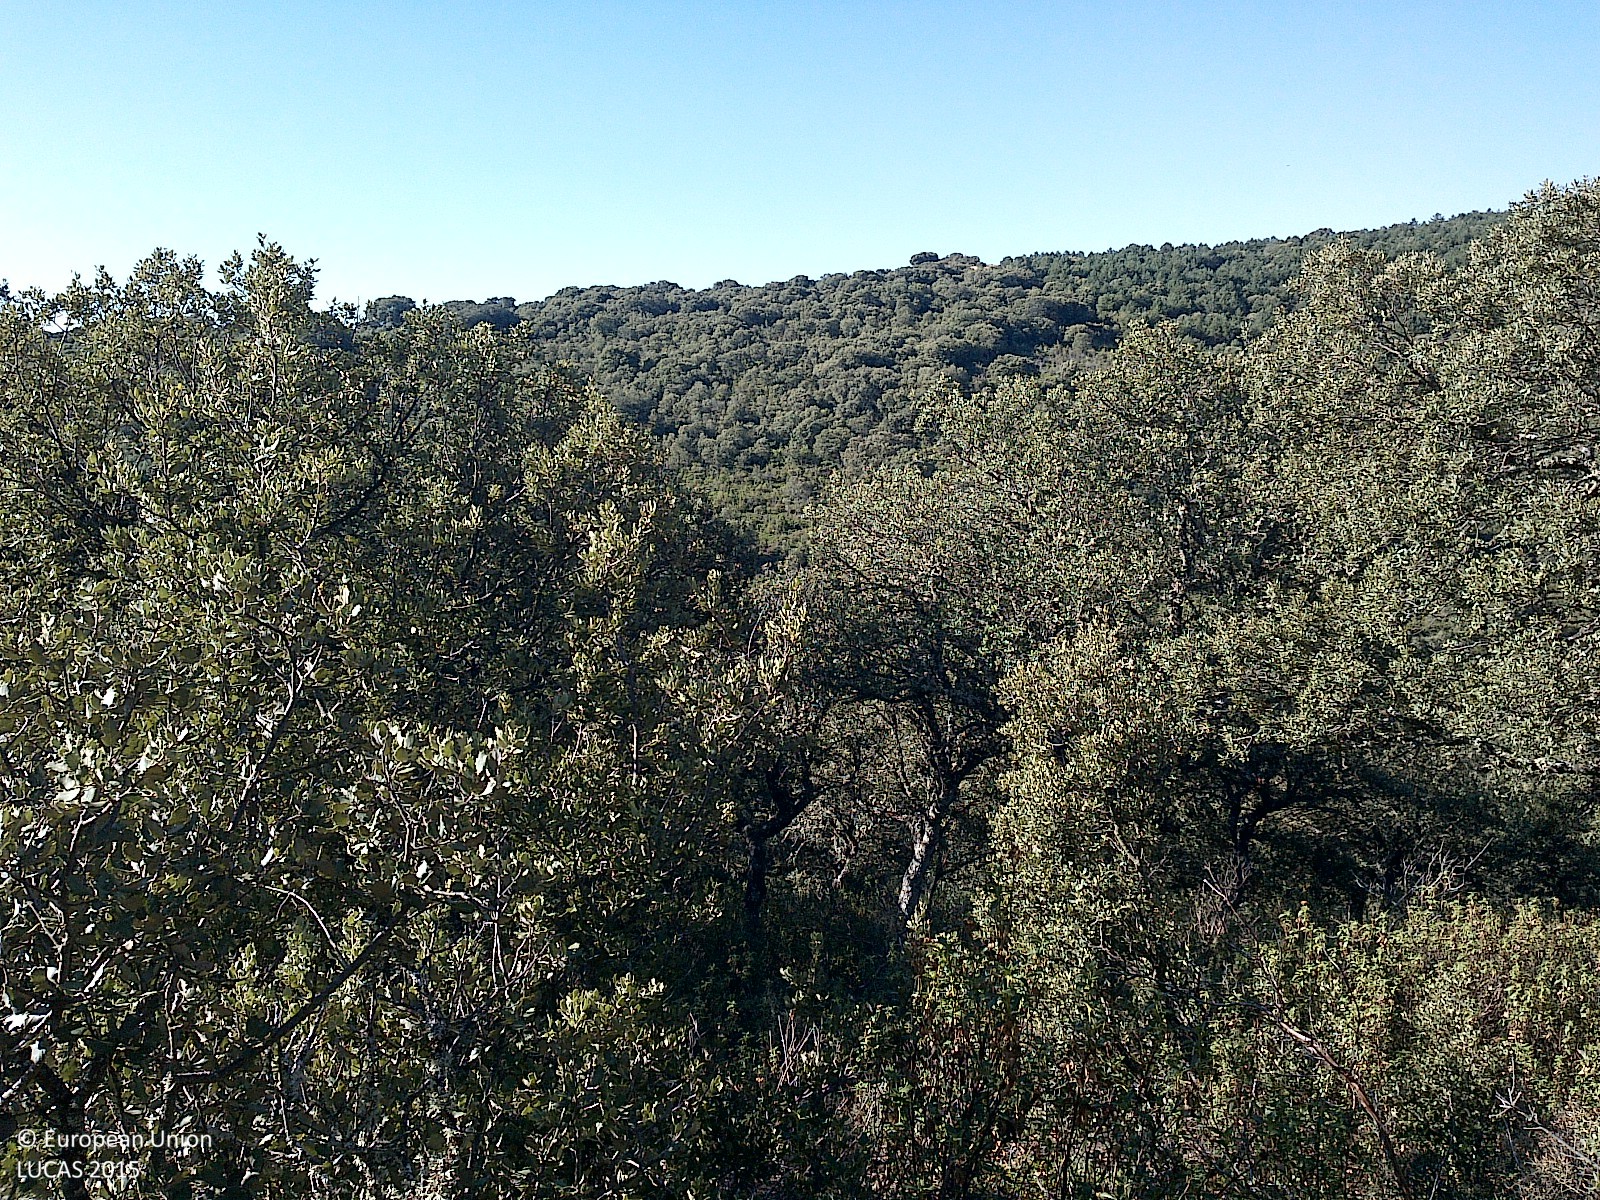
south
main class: Woodland
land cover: Broadleaved woodland
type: broadleaved evergreen forest
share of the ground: 50 - 75 %
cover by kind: broadleaved forest trees 70 %, shrubs 25 %, herbaceous plants 5 %
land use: Forestry
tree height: > 5 m
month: July
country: ES
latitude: 41.9134
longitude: -2.2015
